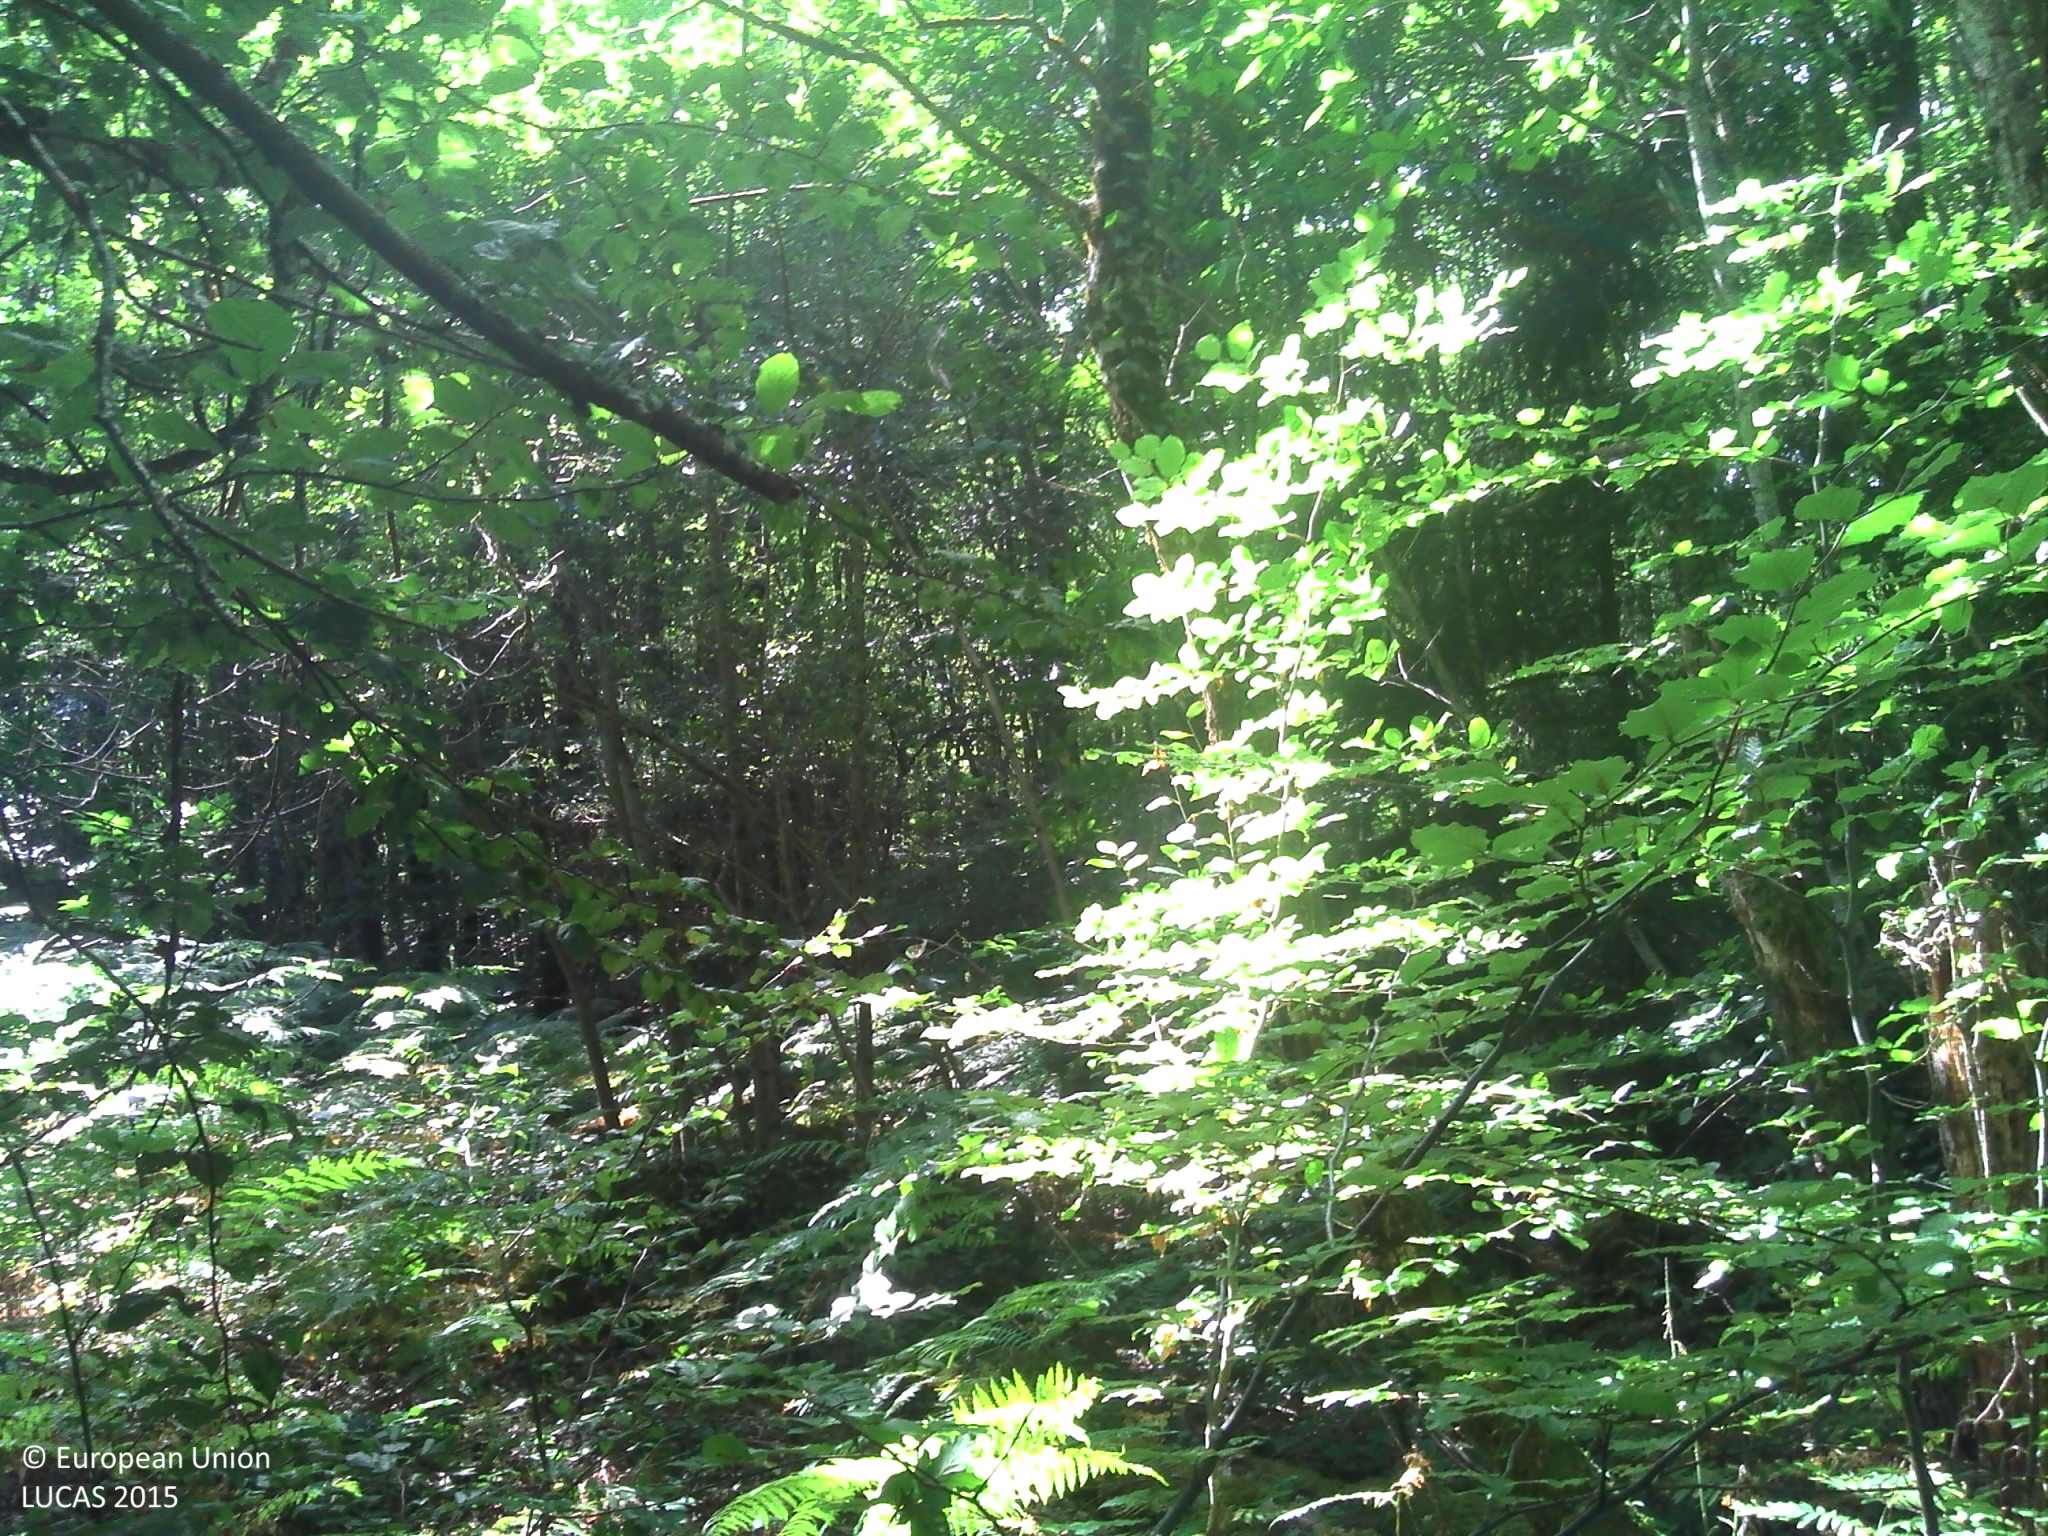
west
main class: Woodland
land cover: Broadleaved woodland
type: acidophilous oak and oak-birch forest
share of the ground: > 75 %
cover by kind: broadleaved forest trees 80 %, shrubs 10 %, herbaceous plants 5 %, lichens and mosses 5 %
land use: Forestry
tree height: > 5 m
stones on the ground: < 10 %
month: August
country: FR
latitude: 46.1067
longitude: 1.7776
